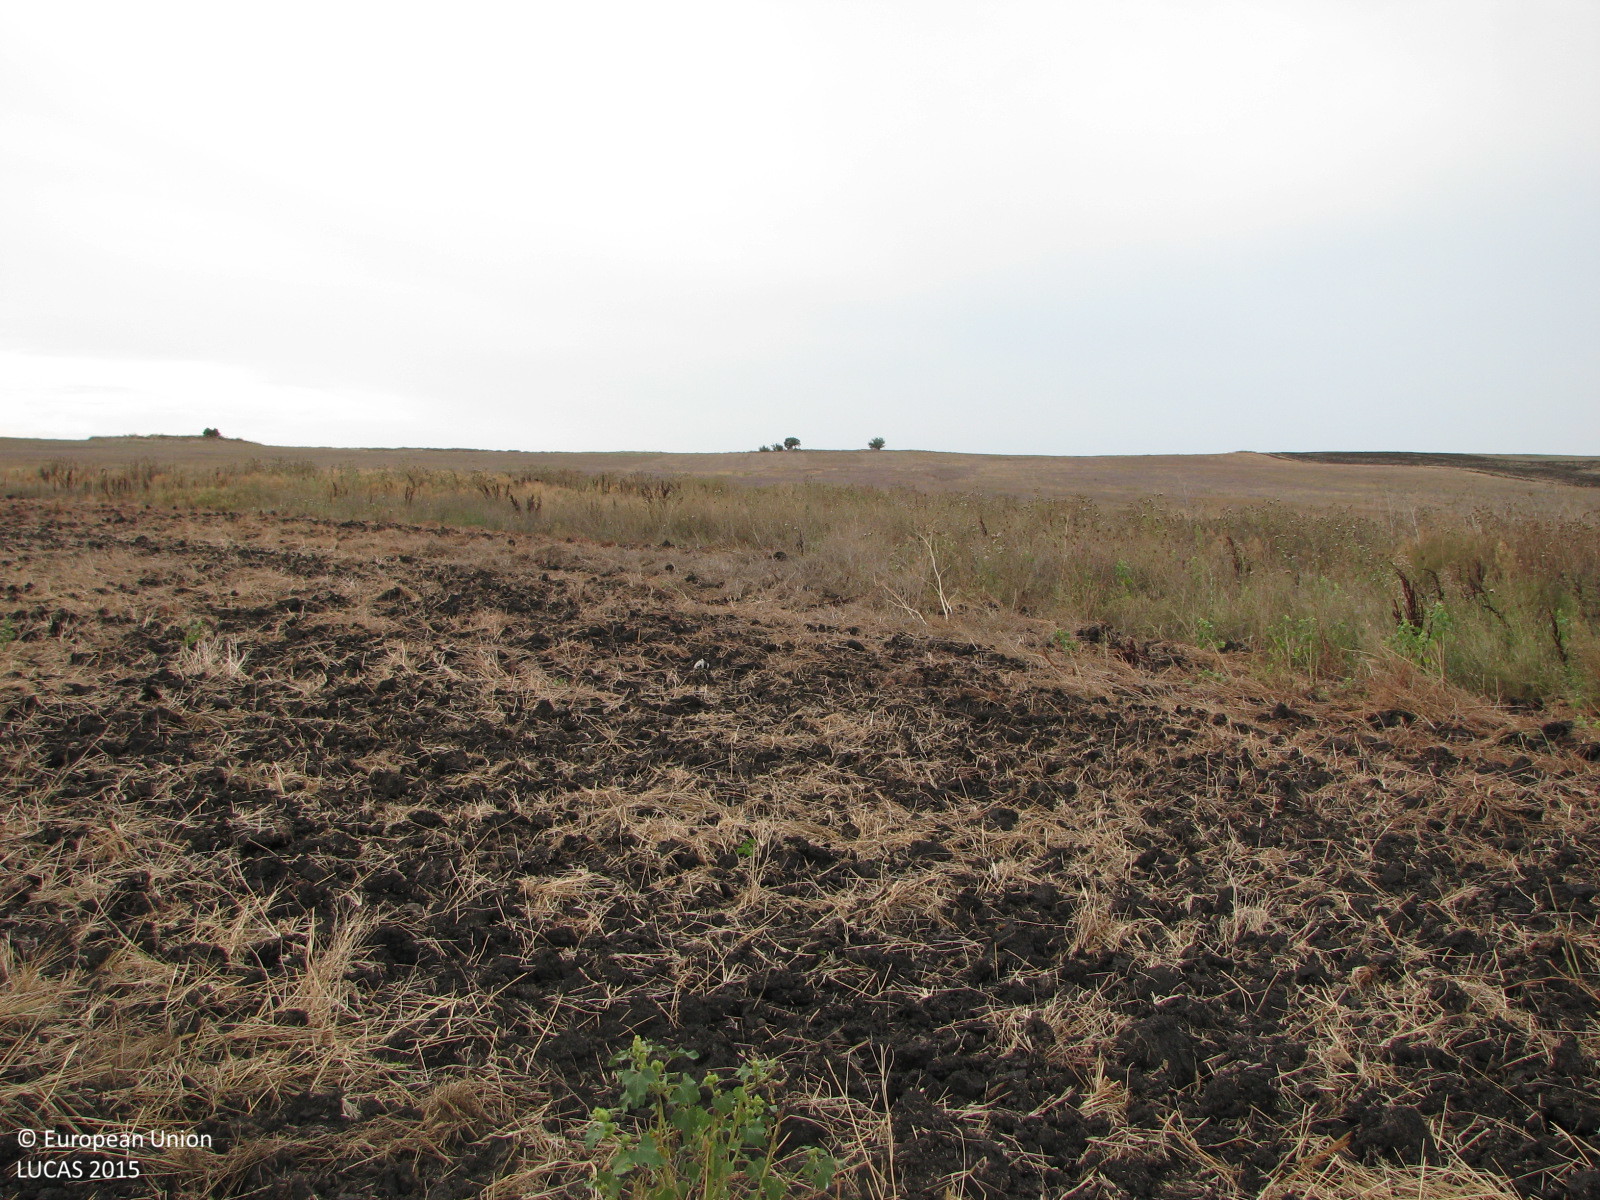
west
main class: Cropland
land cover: Common wheat
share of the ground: < 10 %
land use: Agriculture (excluding fallow land and kitchen gardens)
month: September
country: BG
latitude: 42.4346
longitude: 26.9131
